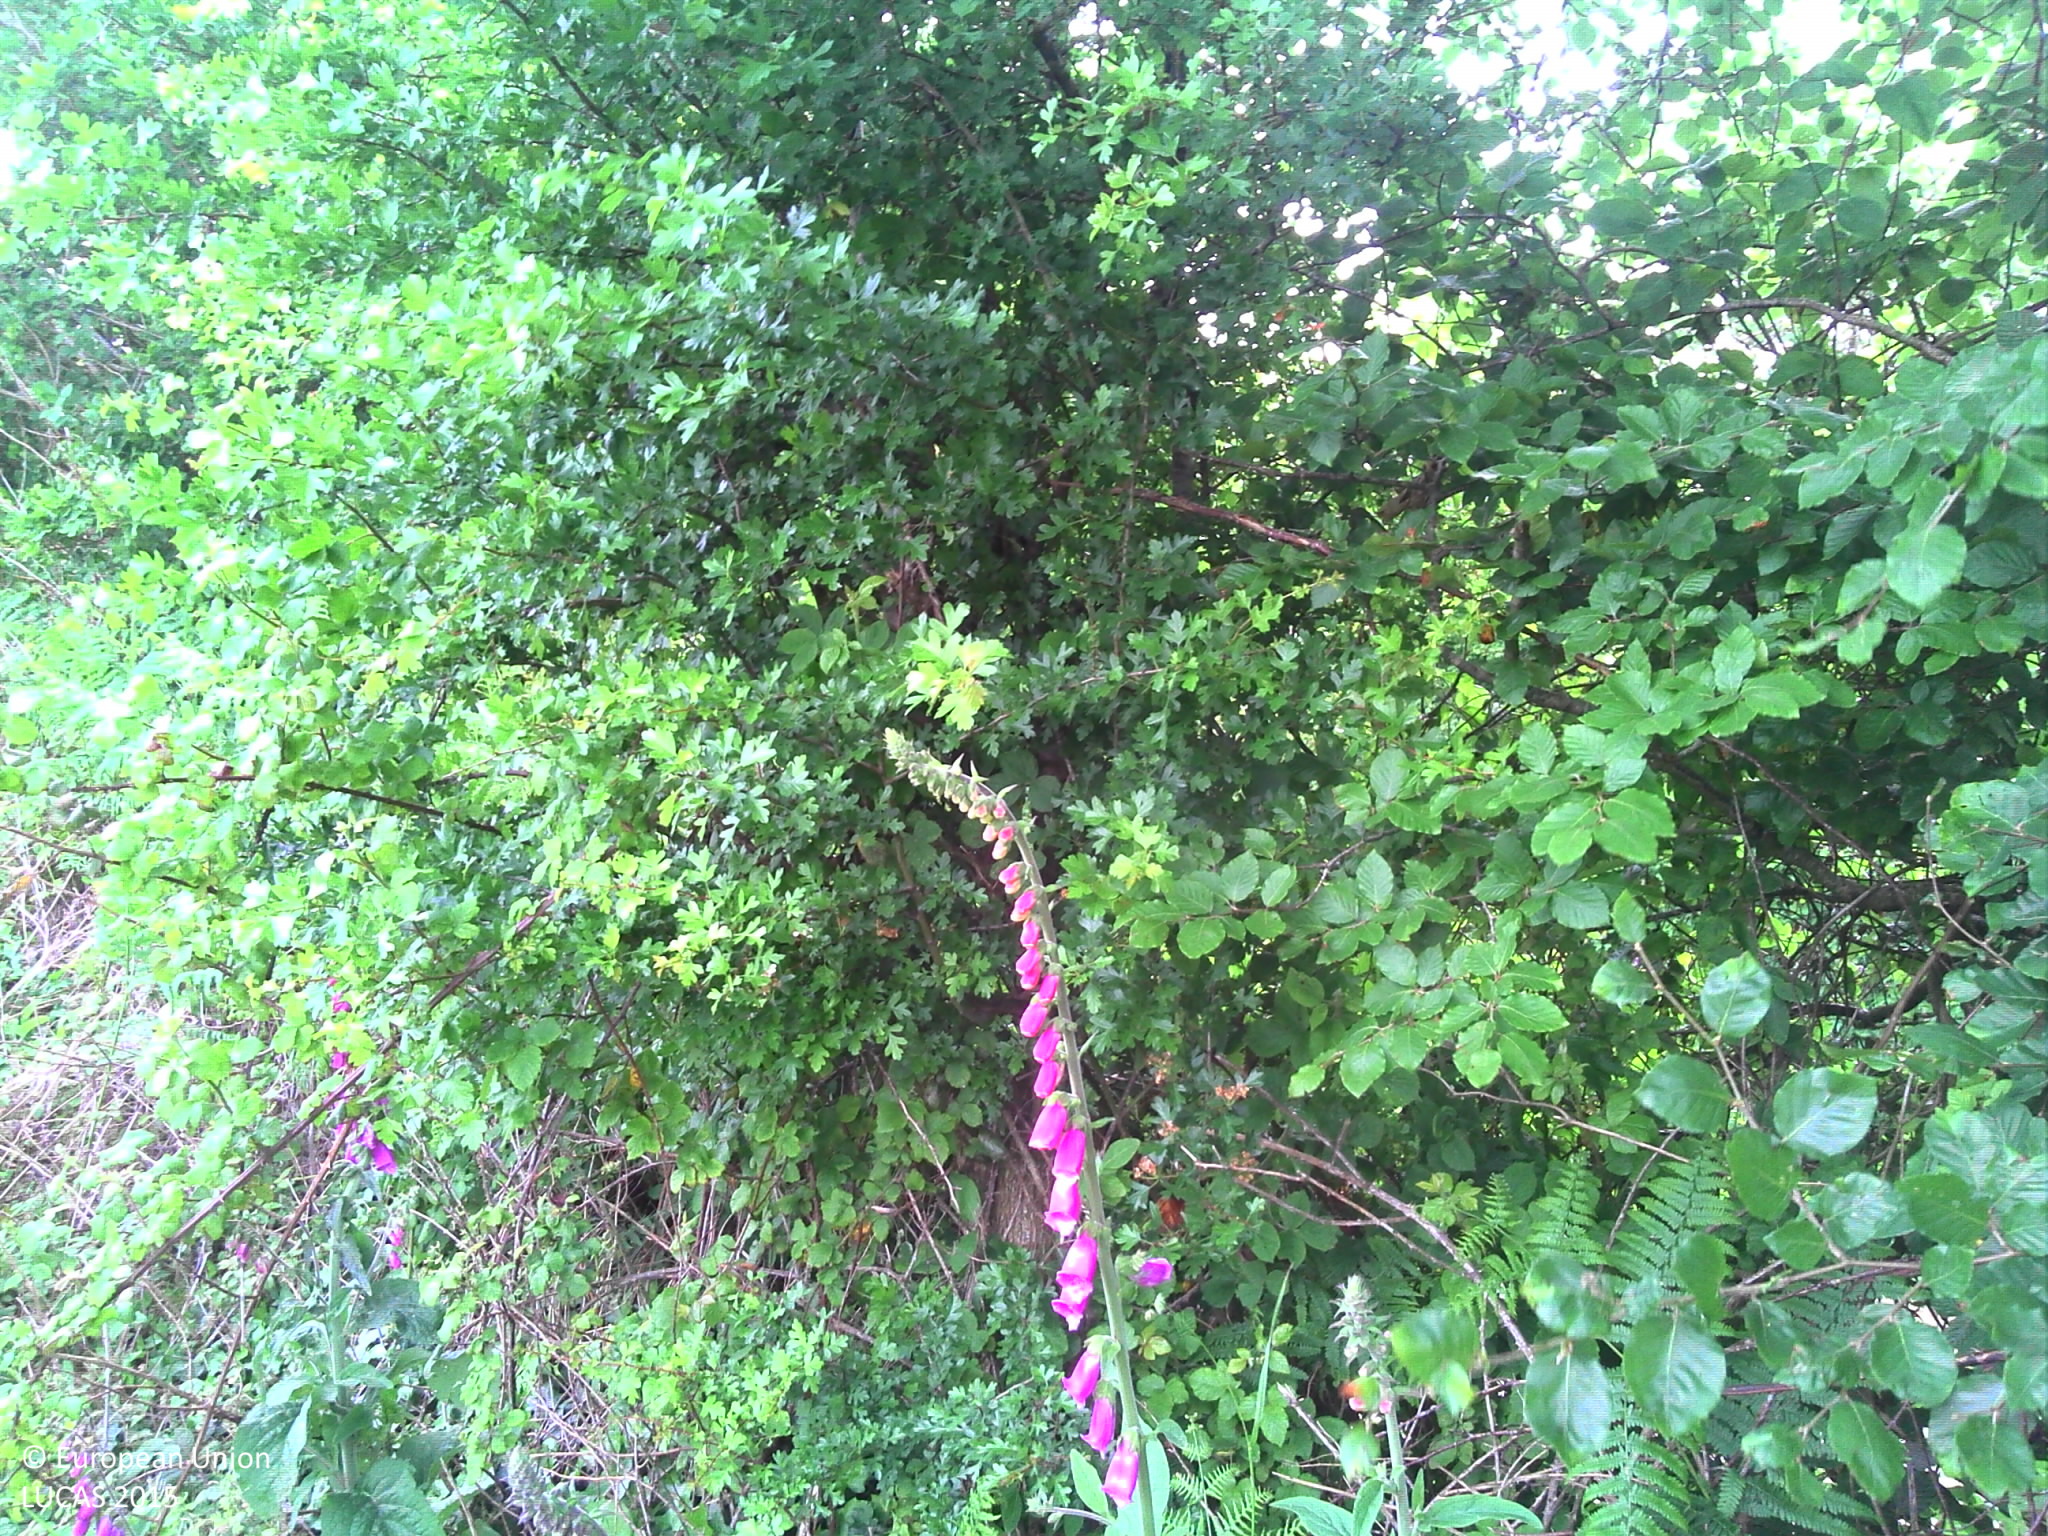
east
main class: Grassland
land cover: Grassland without tree/shrub cover
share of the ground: > 75 %
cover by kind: herbaceous plants 100 %
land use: Agriculture (excluding fallow land and kitchen gardens)
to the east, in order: Abandoned hedges; Grass margins; Paved roads, cycling and walking lanes; Grass margins; Ditches and canals; Abandoned hedges; Fences; Grassland without tree/shrub cover; Abandoned hedges; Fences; Grassland without tree/shrub cover; Fences; Abandoned hedges; Artificial constructions in urban areas
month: June
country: FR
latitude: 49.5300
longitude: -1.4753
